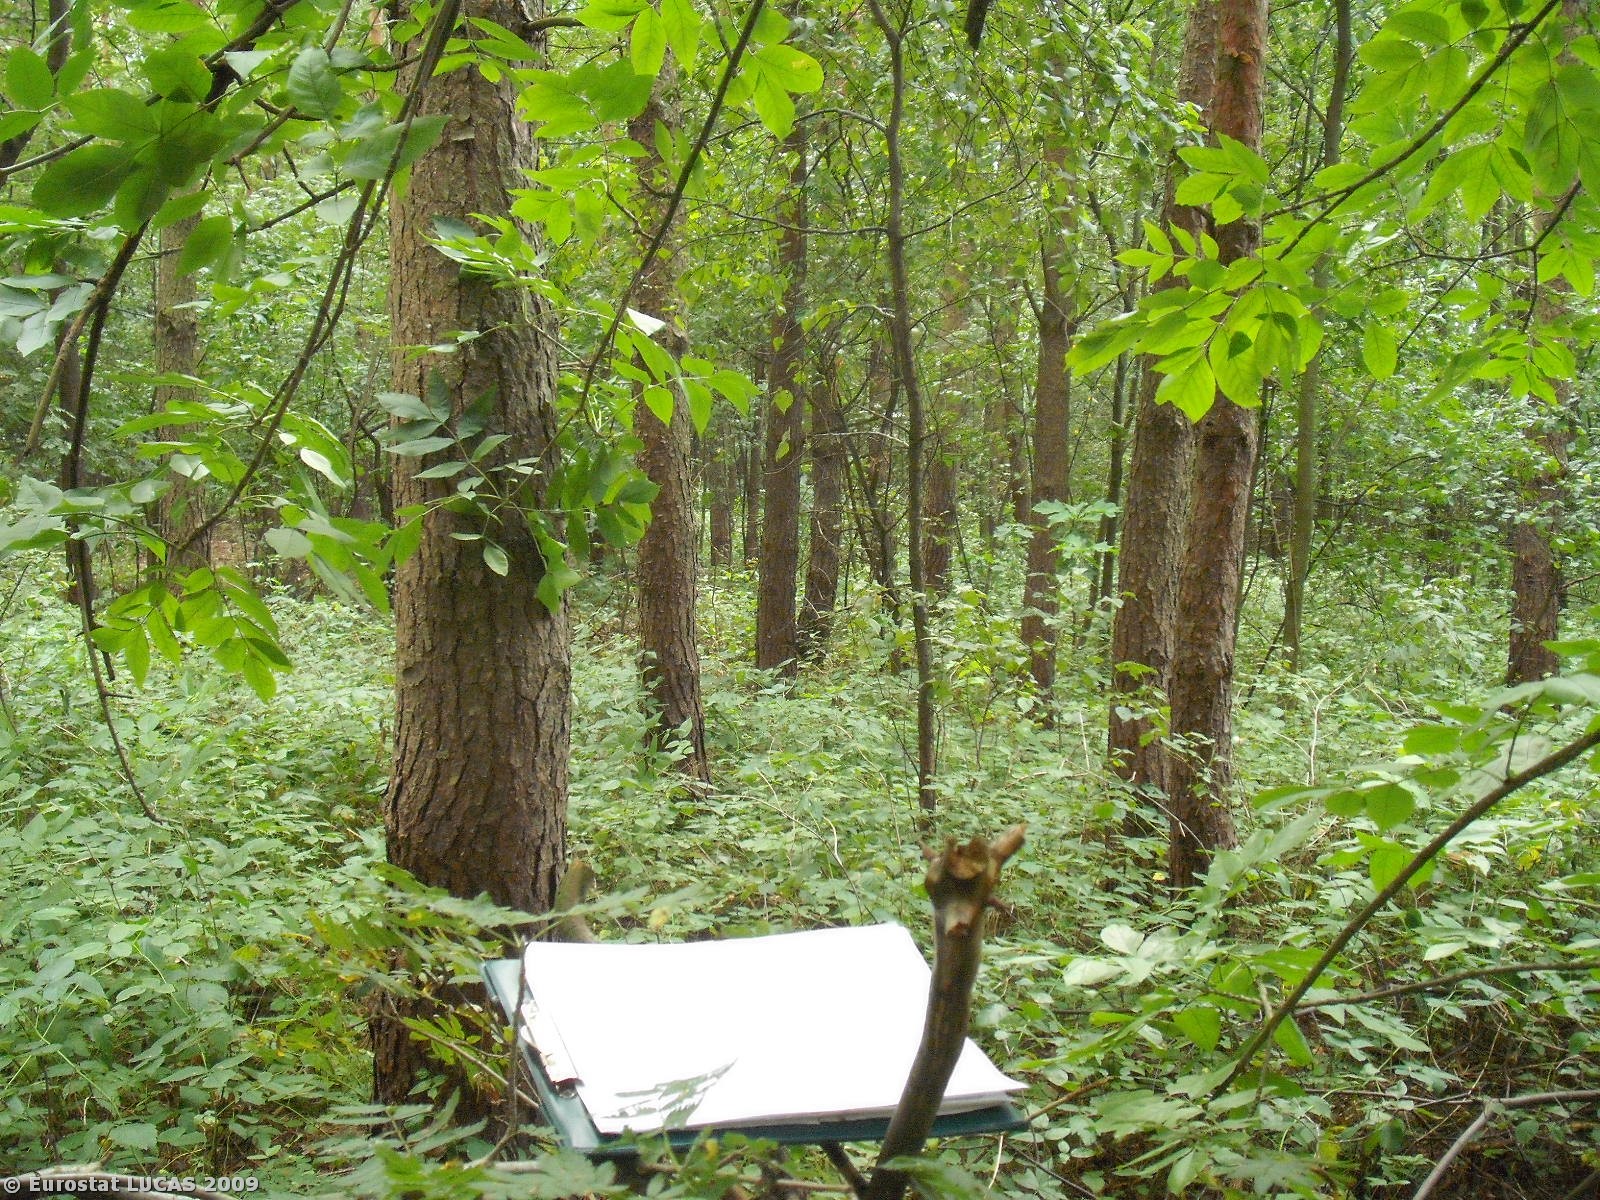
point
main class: Woodland
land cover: Coniferous woodland
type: hemiboreal forest and nemoral coniferous forest and mixed broadleaved-coniferous forest
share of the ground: > 75 %
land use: Forestry
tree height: > 5 m
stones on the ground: < 10 %
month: August
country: PL
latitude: 51.7700
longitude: 21.6023
